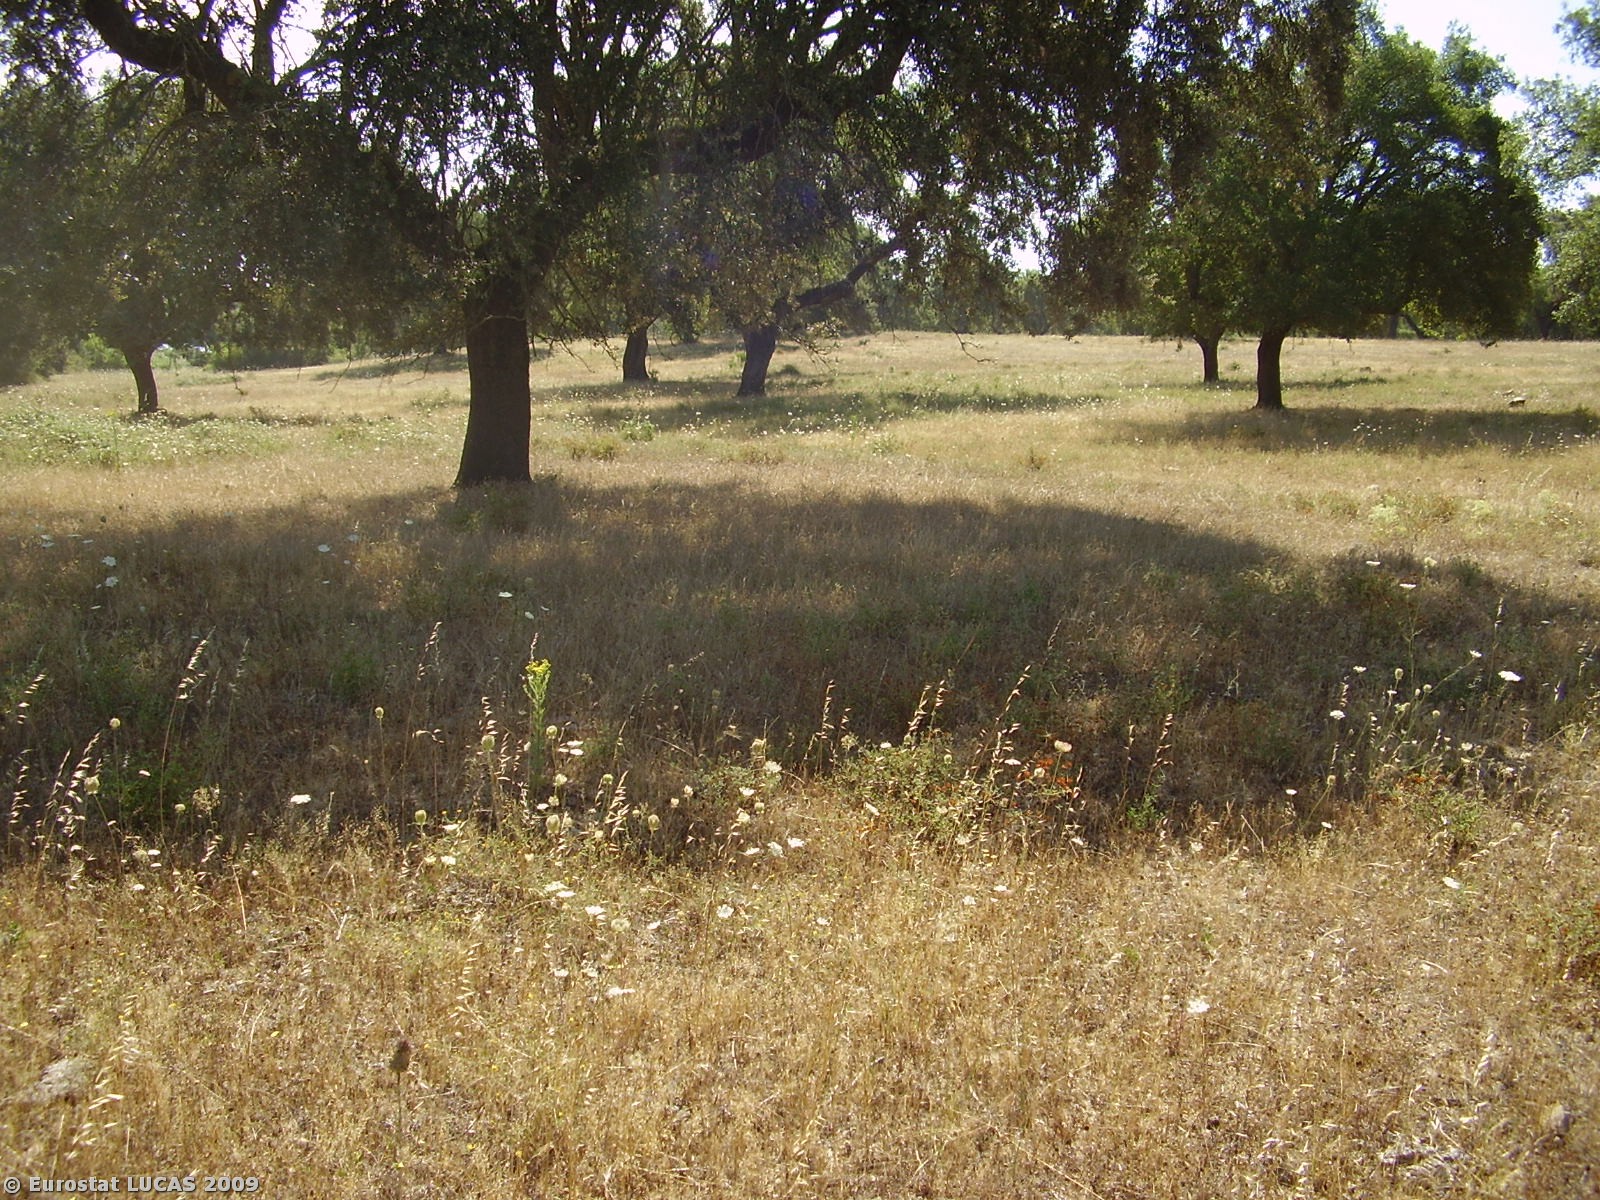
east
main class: Woodland
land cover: Broadleaved woodland
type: broadleaved evergreen forest
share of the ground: 10 - 25 %
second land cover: Spontaneously vegetated surfaces
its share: > 75 %
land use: Forestry
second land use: Fallow land
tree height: > 5 m
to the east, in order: Broadleaved woodland; Spontaneously vegetated surfaces; Broadleaved woodland; Tracks; Fences; Bare land; Spontaneously vegetated surfaces
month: July
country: PT
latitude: 38.7088
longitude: -8.1368
